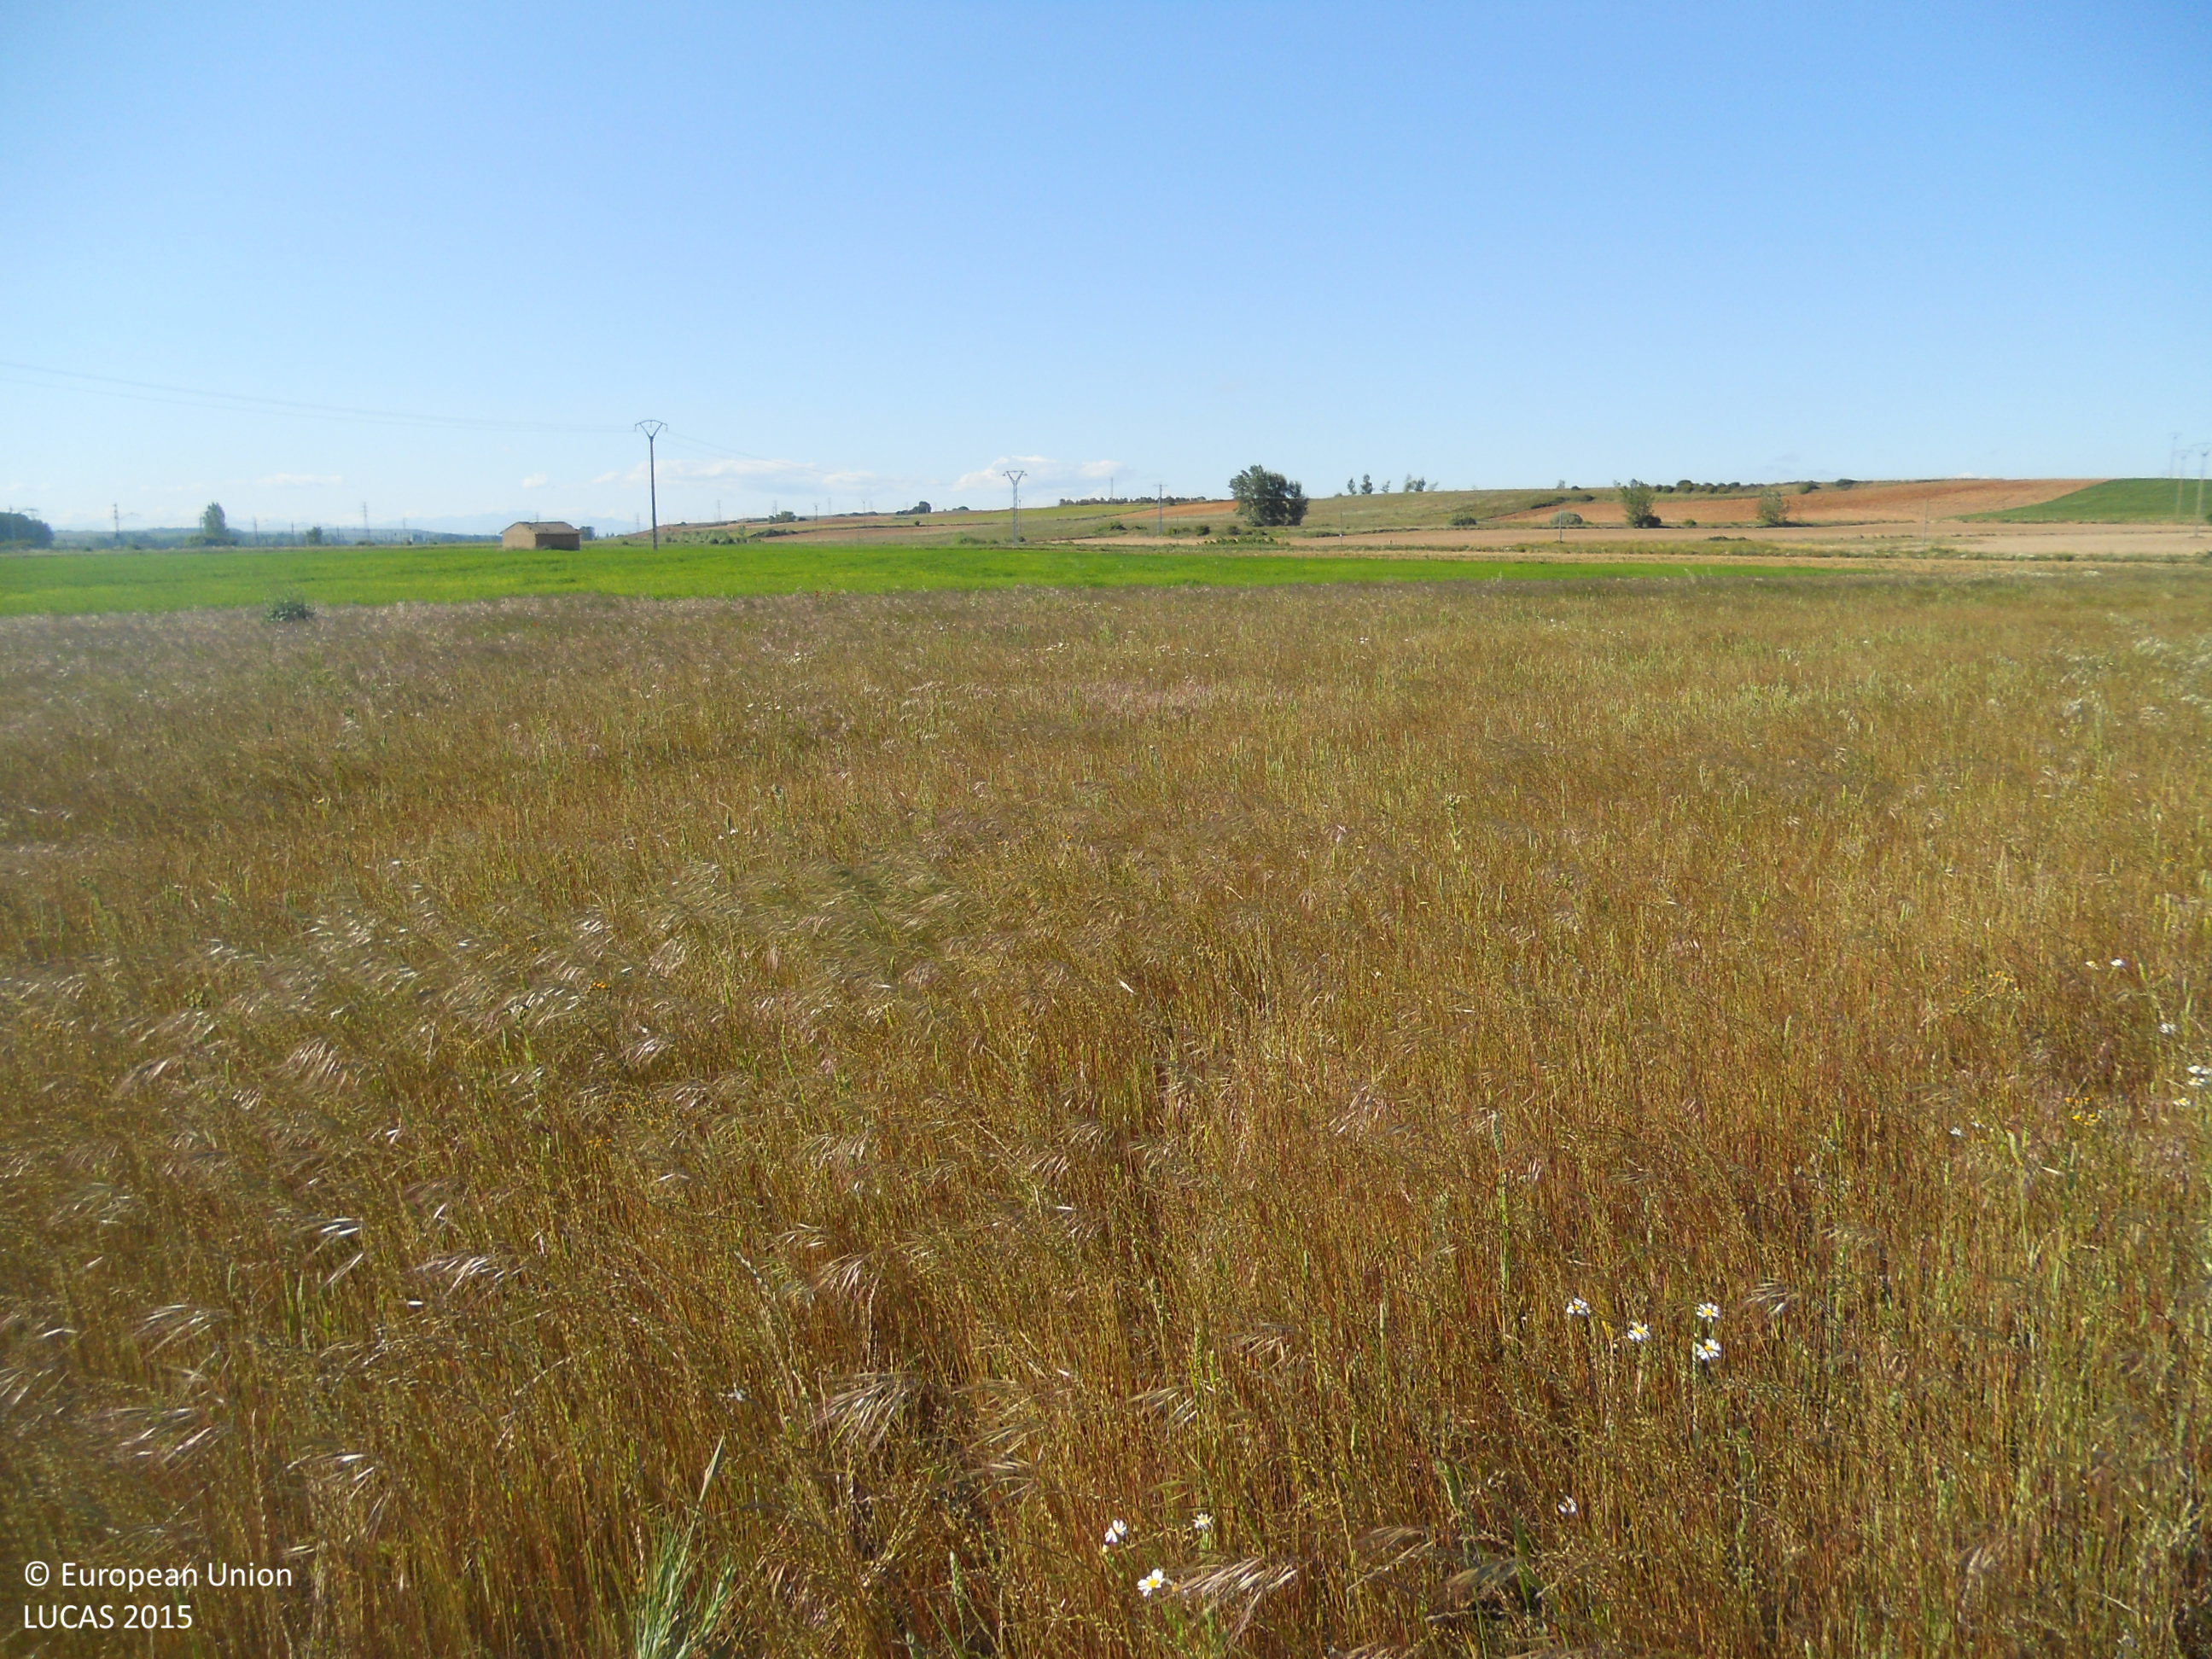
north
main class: Grassland
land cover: Spontaneously vegetated surfaces
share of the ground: > 75 %
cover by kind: herbaceous plants 100 %
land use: Fallow land
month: May
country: ES
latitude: 42.4313
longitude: -4.3545
